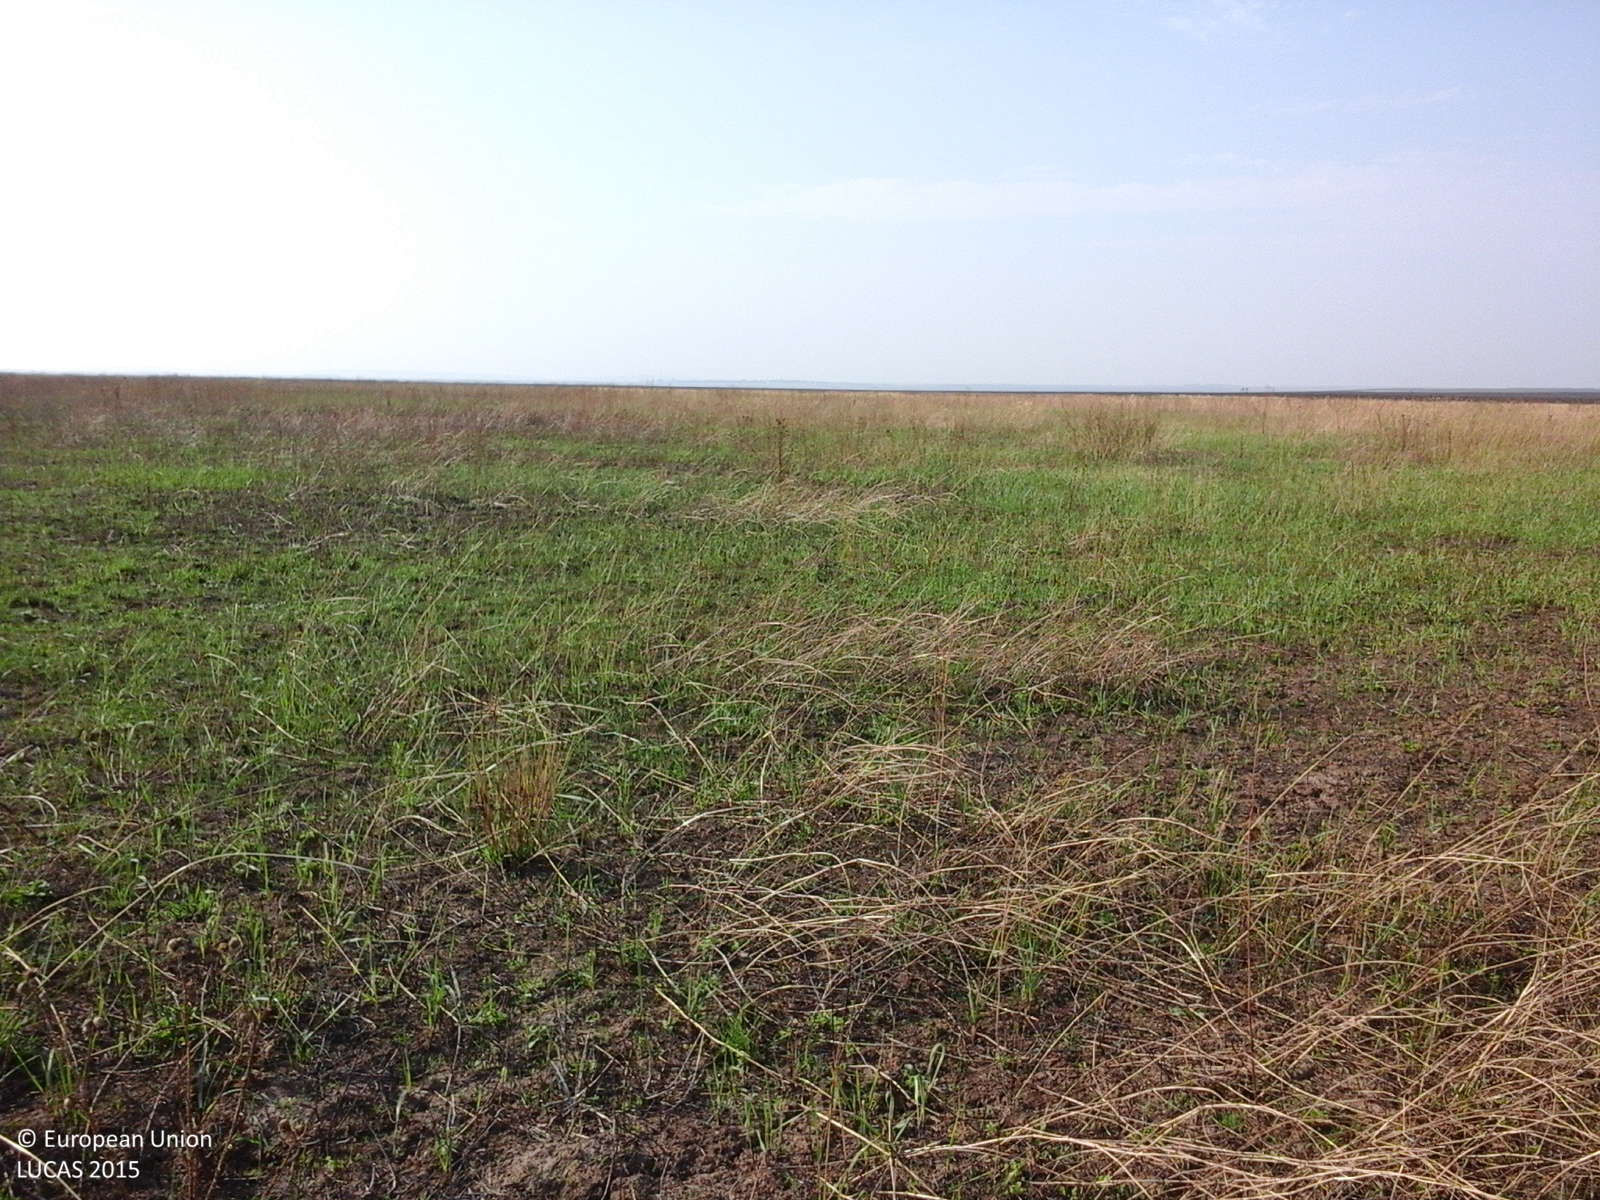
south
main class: Grassland
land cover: Grassland without tree/shrub cover
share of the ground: > 75 %
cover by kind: herbaceous plants 100 %
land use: Agriculture (excluding fallow land and kitchen gardens)
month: August
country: RO
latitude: 46.0616
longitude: 21.4492
